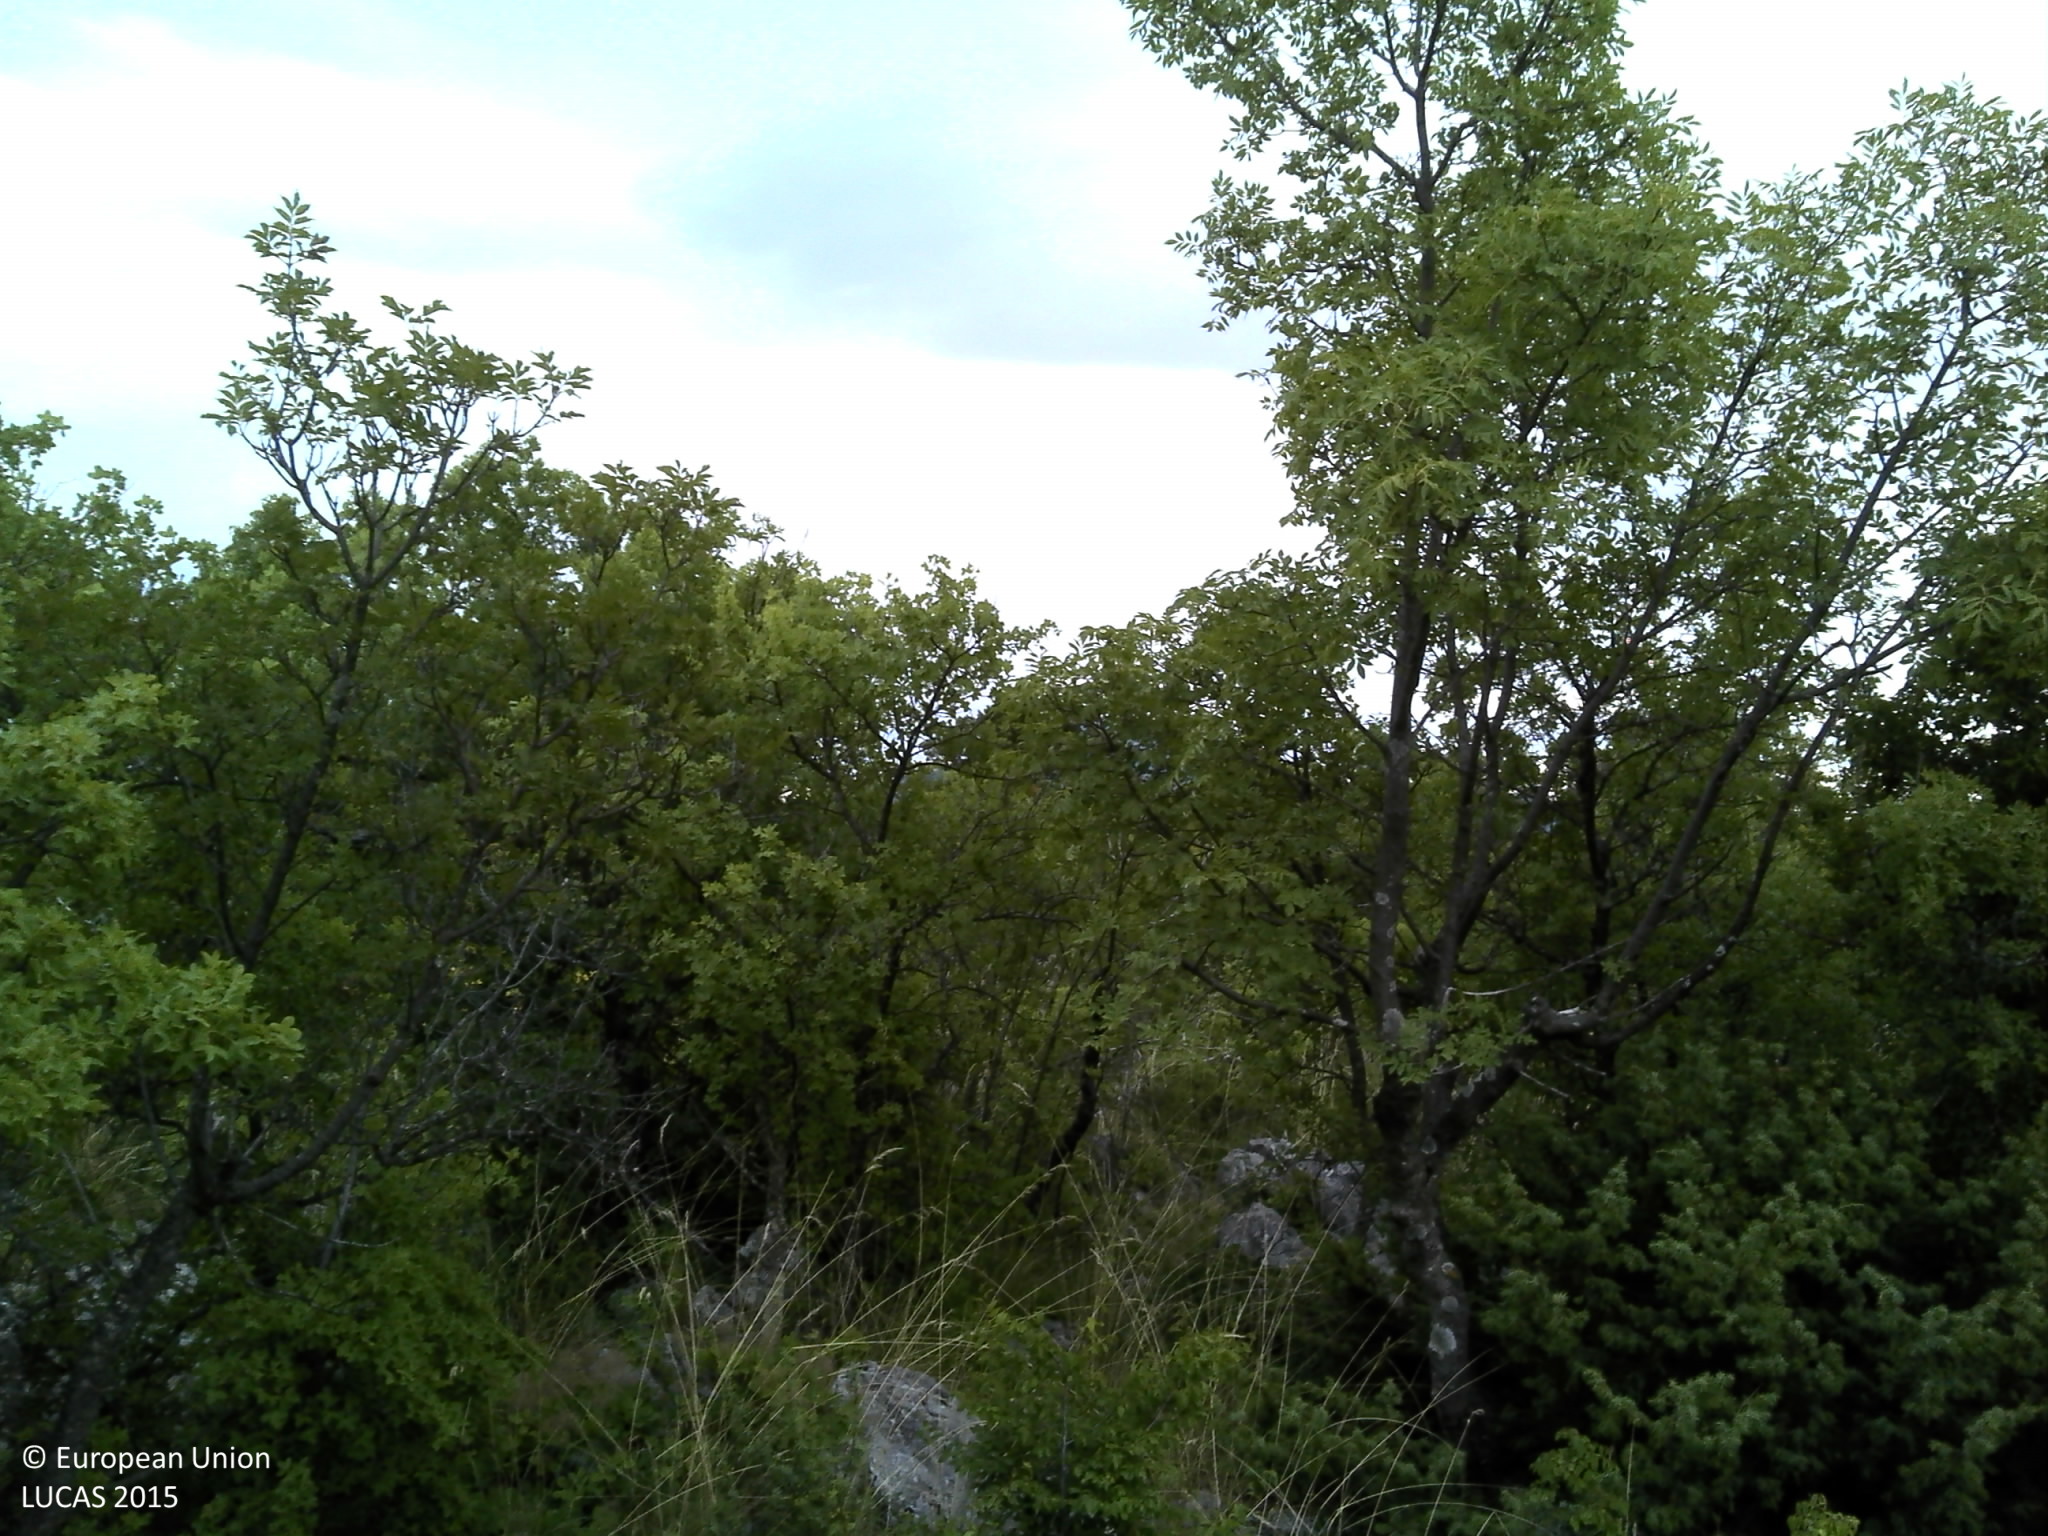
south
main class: Woodland
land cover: Broadleaved woodland
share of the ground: 10 - 25 %
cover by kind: shrubs 40 %, unconsolidated bare surface 30 %, broadleaved forest trees 20 %, consolidated bare surface 10 %
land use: Semi-natural and natural areas not in use
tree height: > 5 m
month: June
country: HR
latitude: 44.0268
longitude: 16.0933
